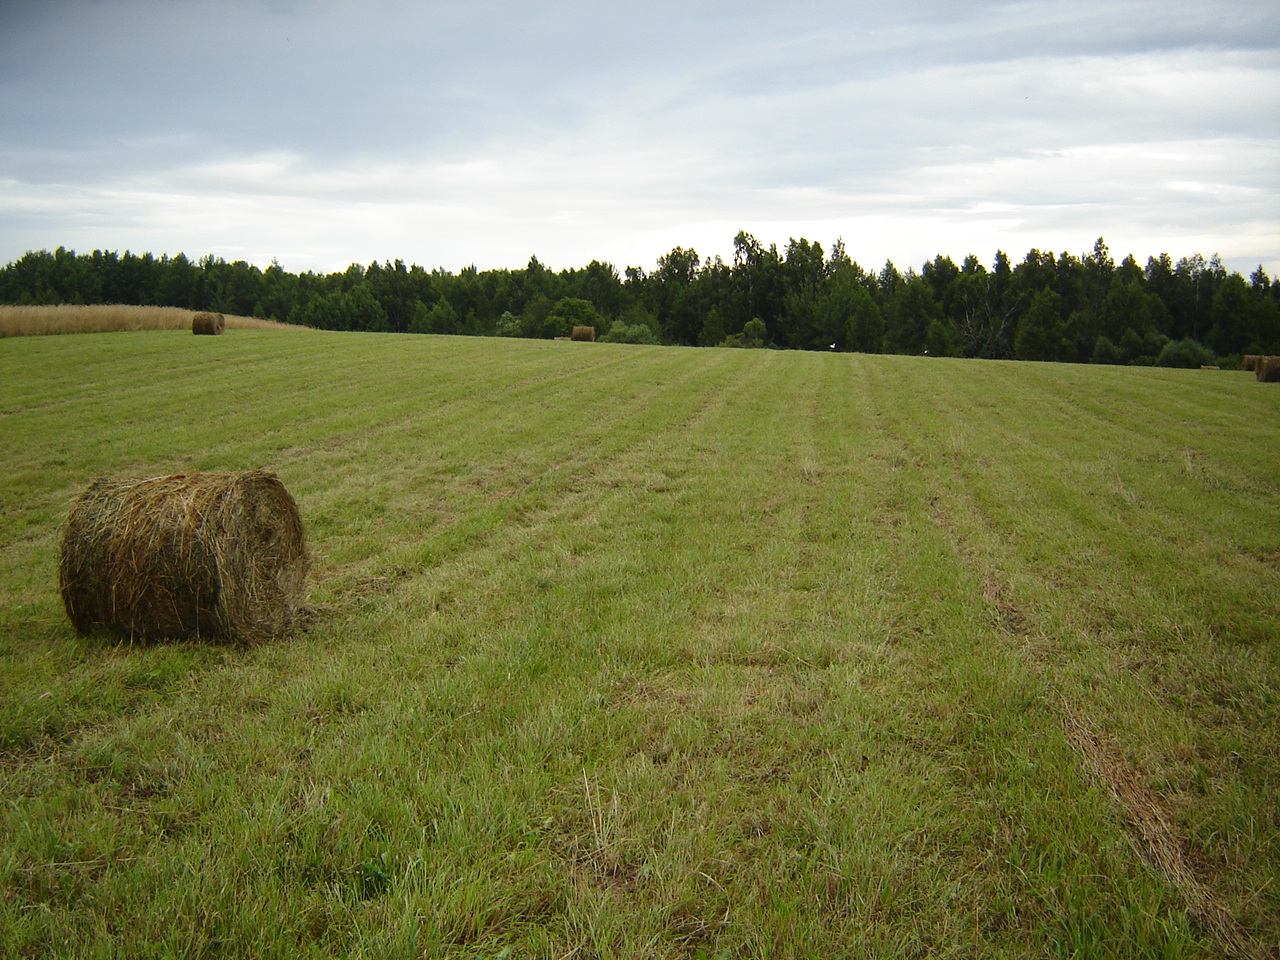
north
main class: Grassland
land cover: Grassland without tree/shrub cover
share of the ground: > 75 %
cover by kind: herbaceous plants 100 %
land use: Agriculture (excluding fallow land and kitchen gardens)
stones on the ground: < 10 %
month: July
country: LT
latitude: 55.4218
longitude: 25.0435
